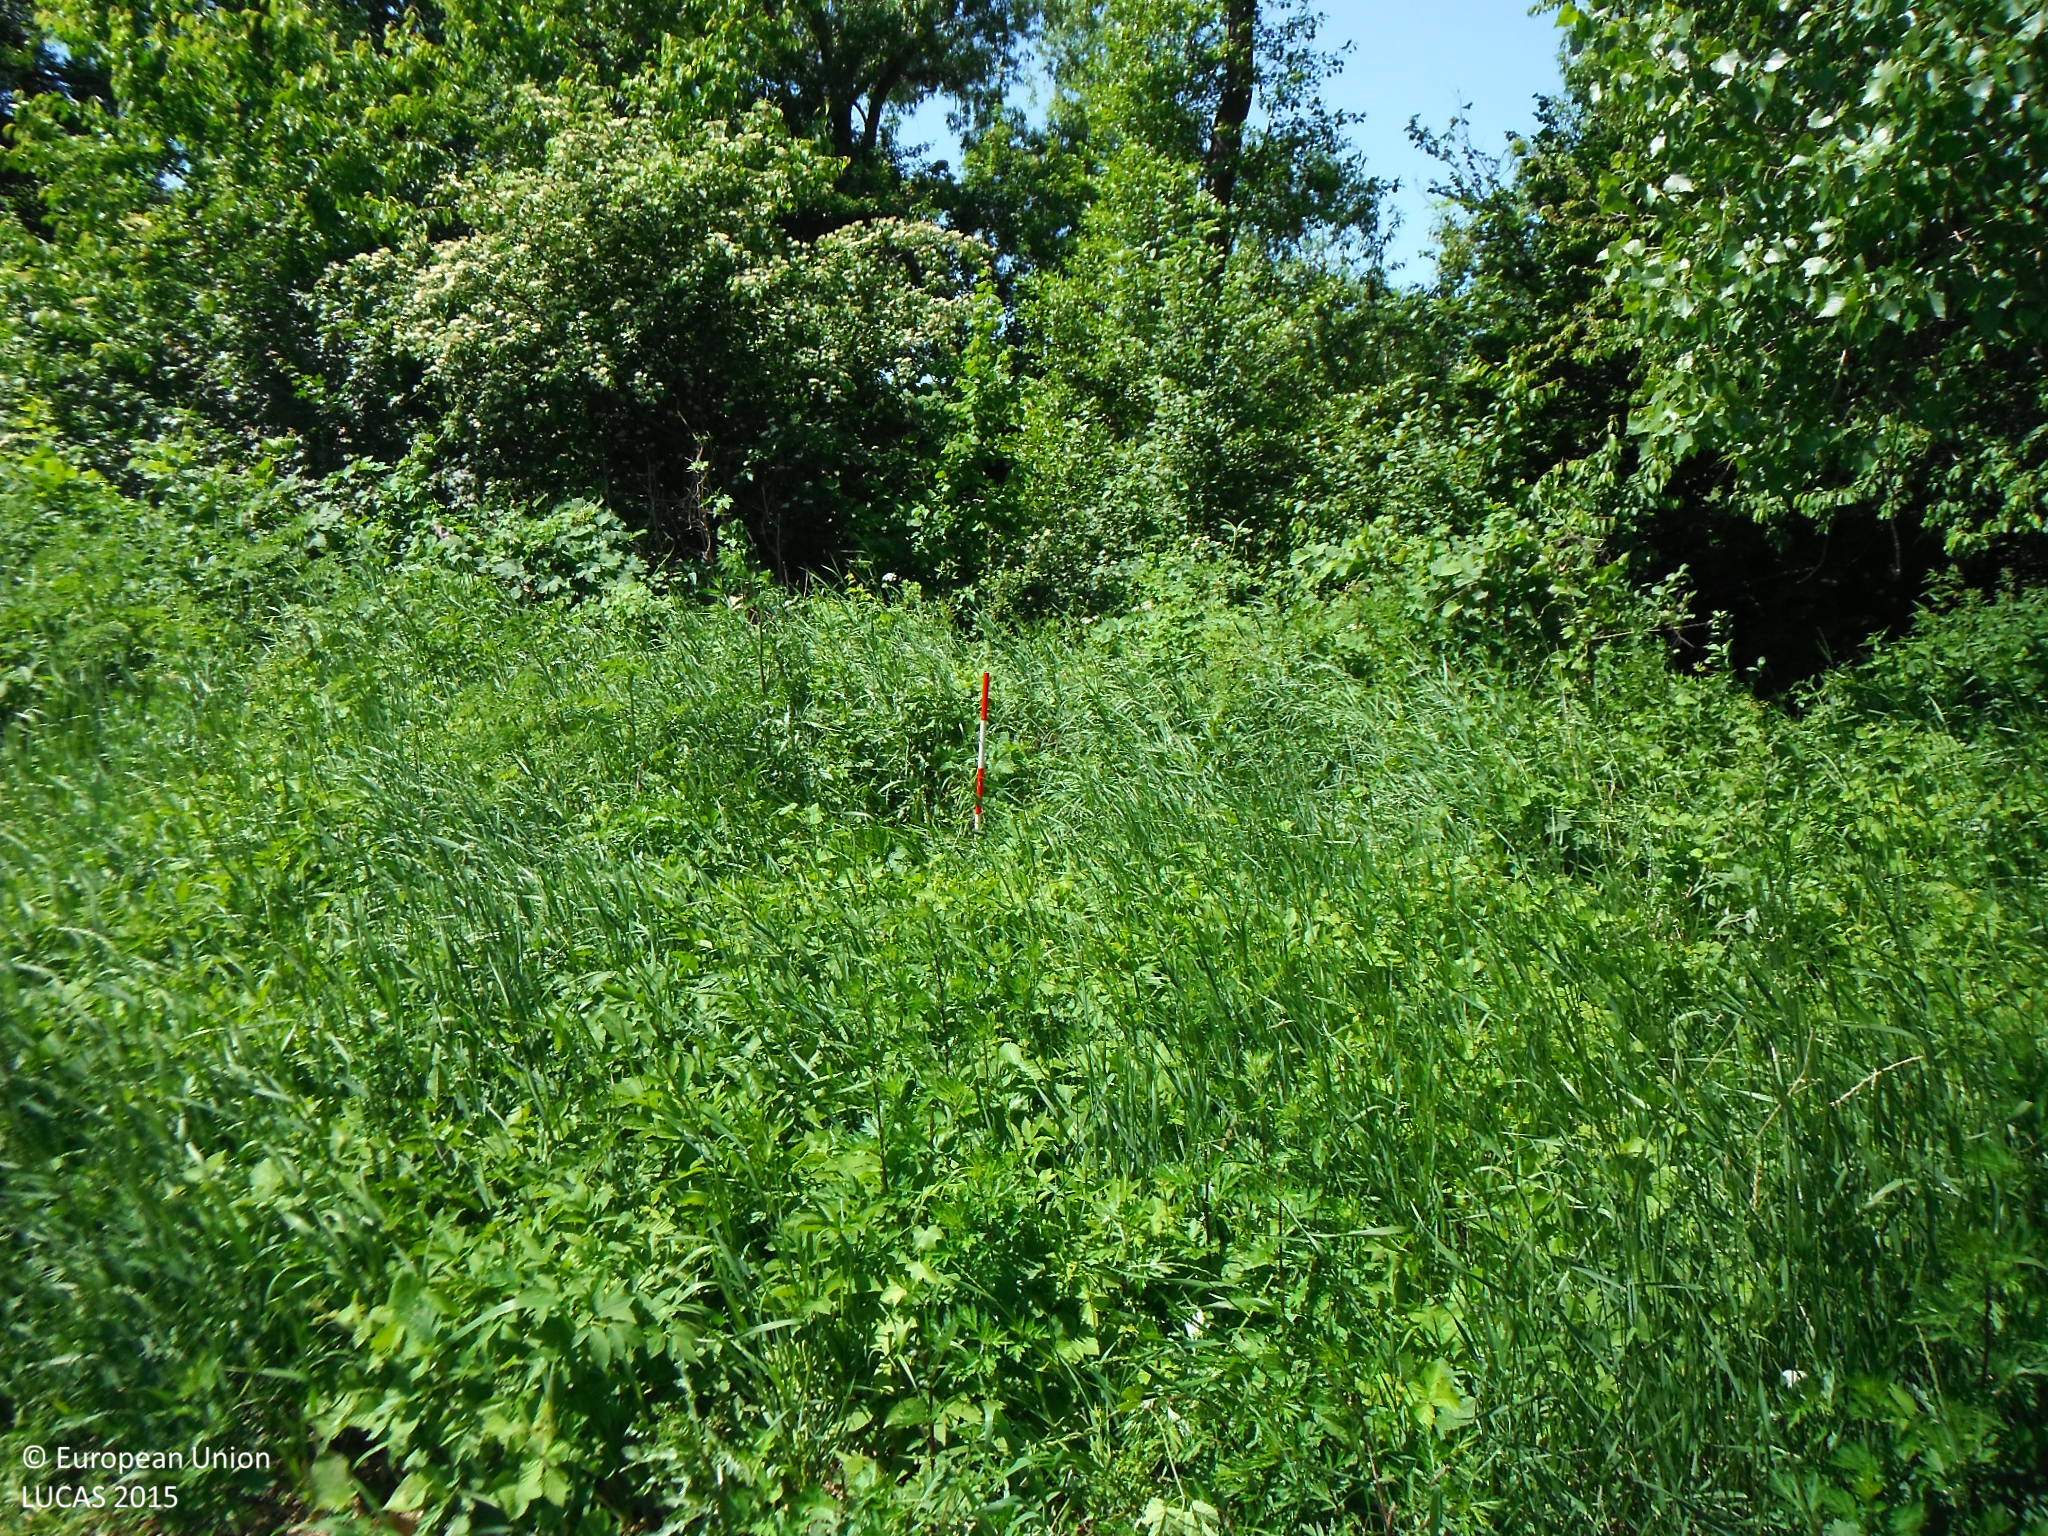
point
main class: Grassland
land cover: Spontaneously vegetated surfaces
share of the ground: > 75 %
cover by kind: herbaceous plants 100 %
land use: Semi-natural and natural areas not in use
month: June
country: SK
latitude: 48.8736
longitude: 21.3213
